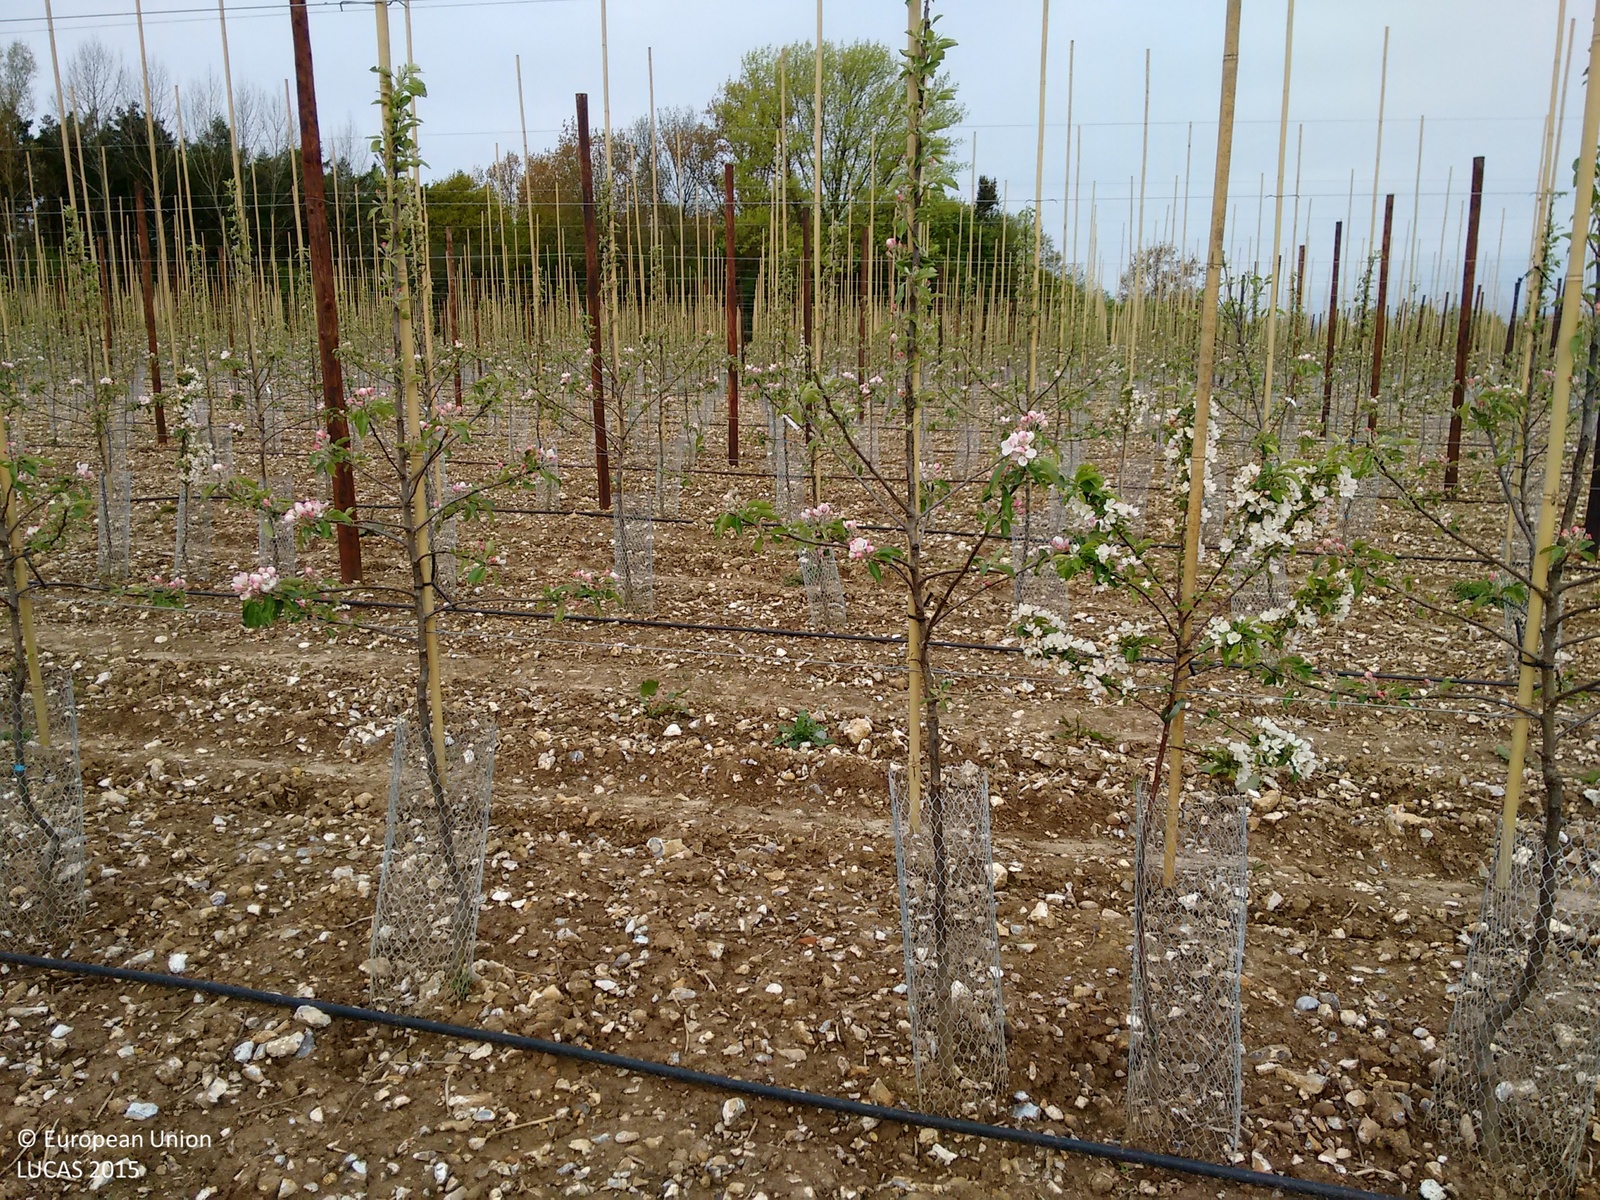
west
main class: Cropland
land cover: Apple fruit
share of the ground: 10 - 25 %
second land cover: Other bare soil
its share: > 75 %
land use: Agriculture (excluding fallow land and kitchen gardens)
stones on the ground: 25 - 50 %
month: May
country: GB
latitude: 51.2897
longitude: 0.7253
